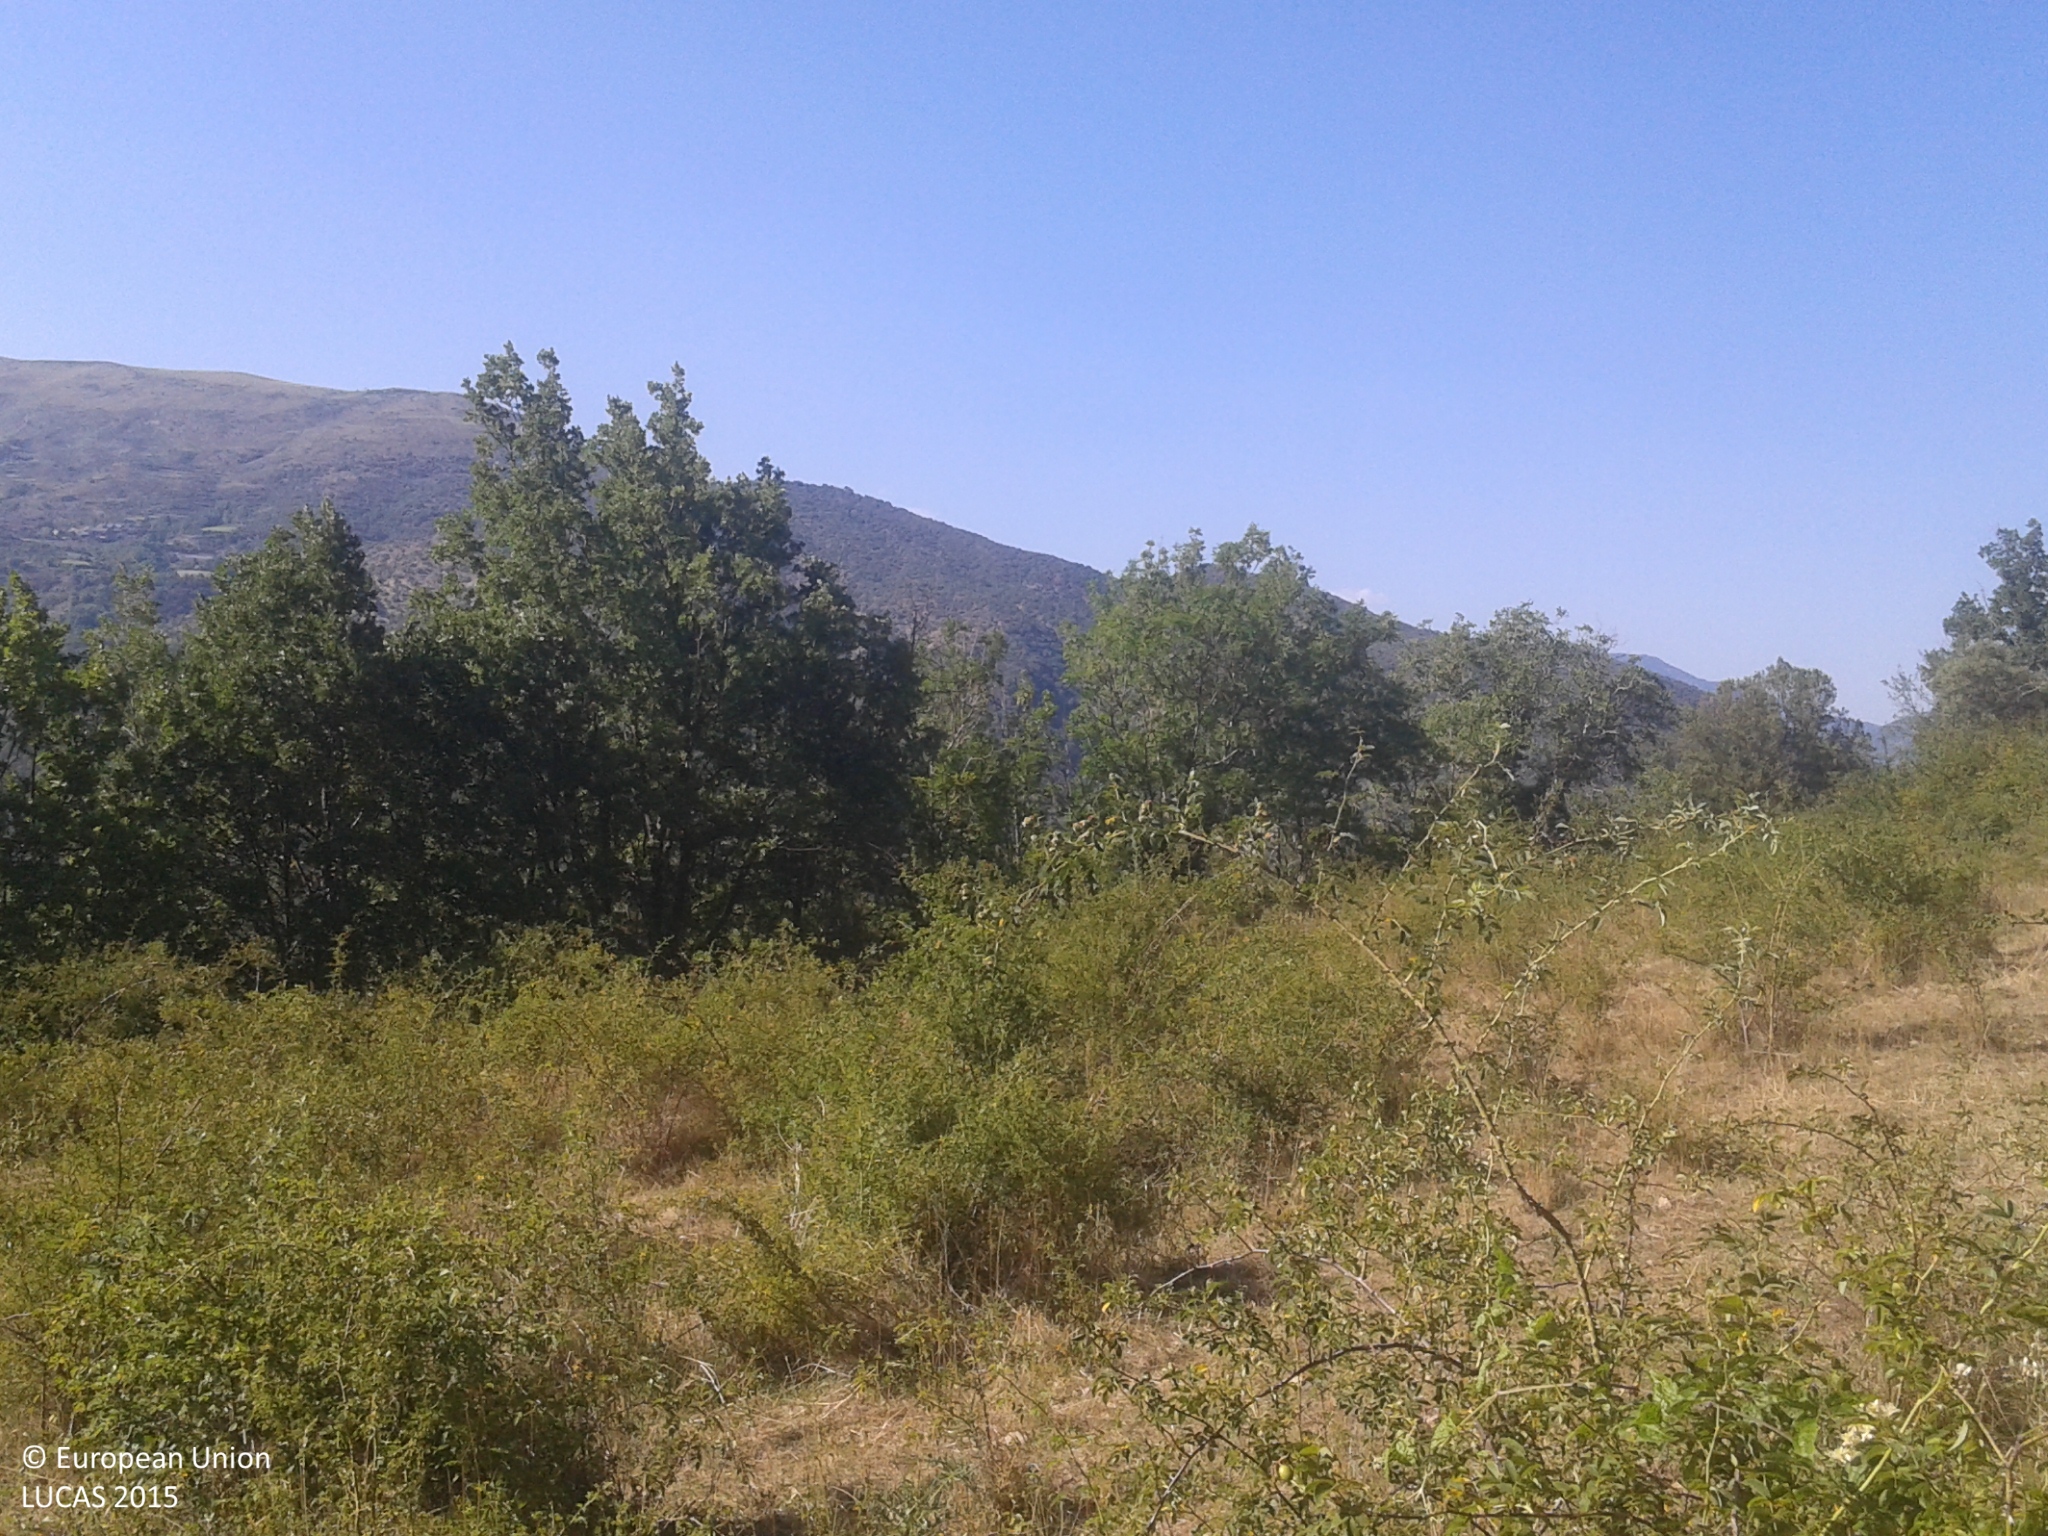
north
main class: Shrubland
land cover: Shrubland without tree cover
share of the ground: 25 - 50 %
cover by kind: herbaceous plants 65 %, shrubs 35 %
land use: Agriculture (excluding fallow land and kitchen gardens)
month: July
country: ES
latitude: 42.3511
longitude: 1.0858
